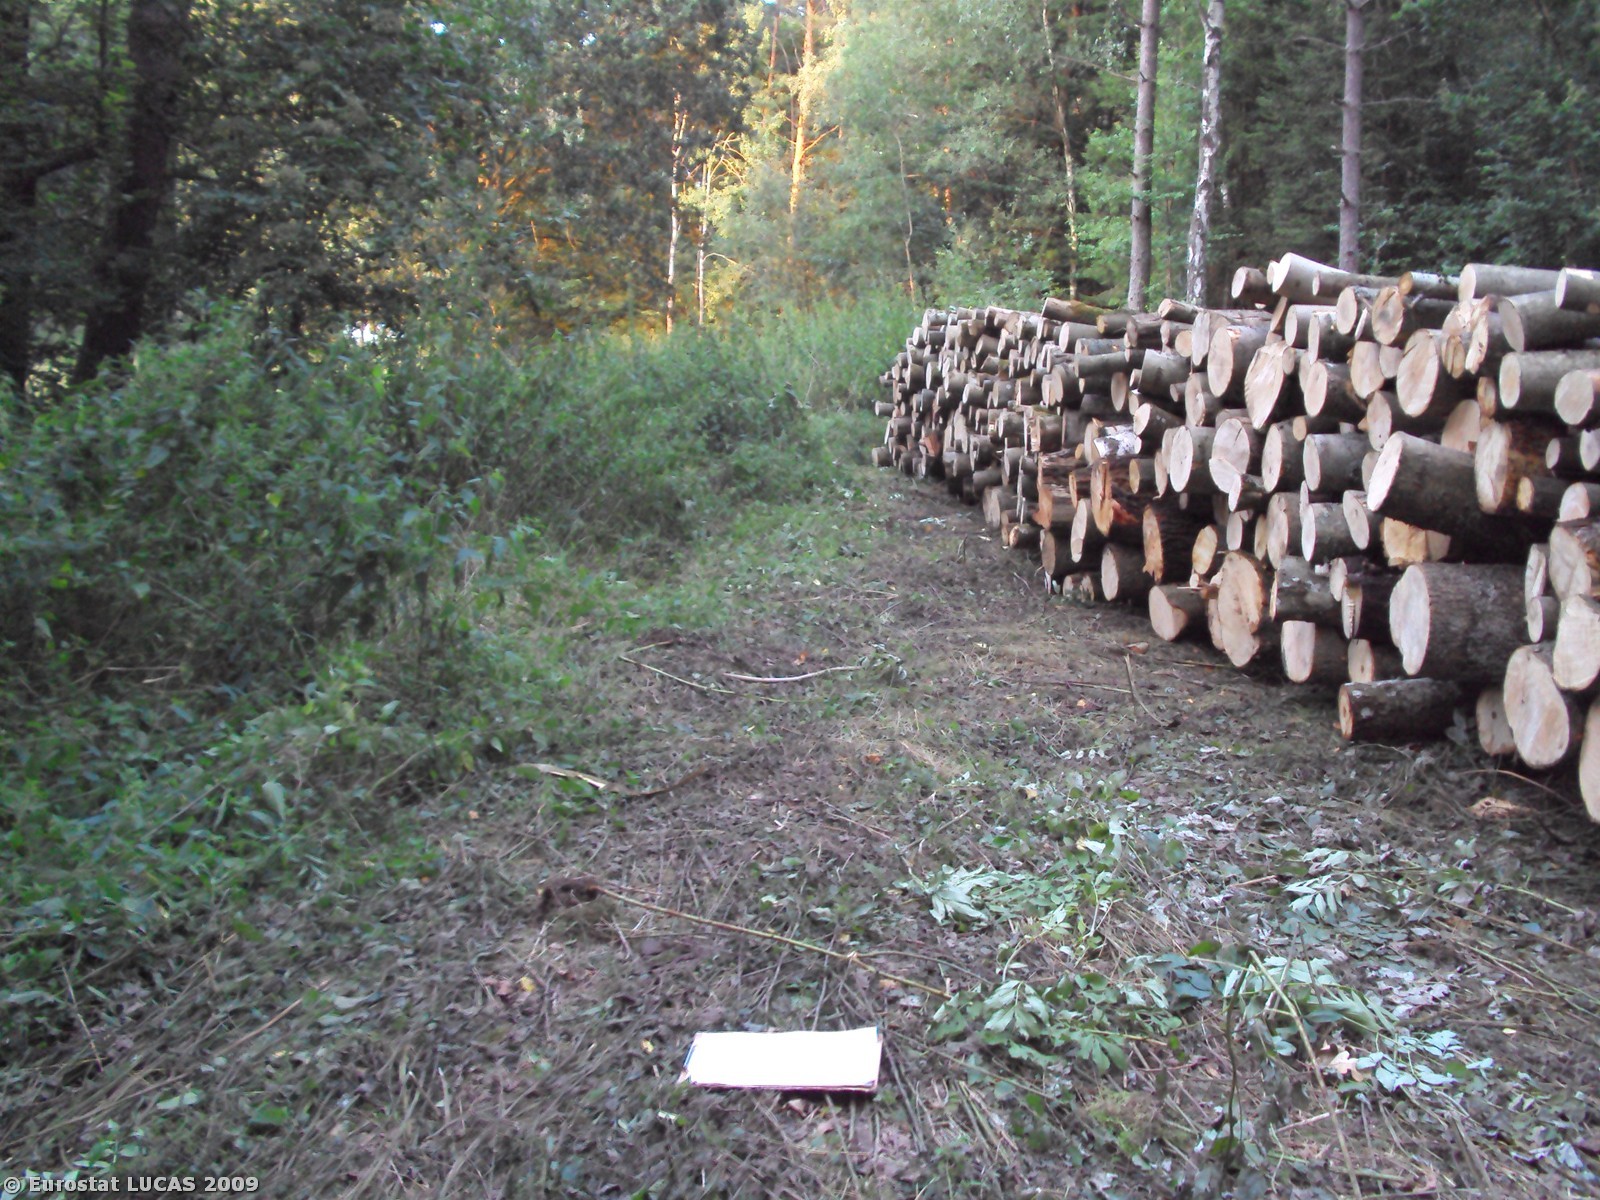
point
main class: Woodland
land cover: Mixed woodland
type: hemiboreal forest and nemoral coniferous forest and mixed broadleaved-coniferous forest
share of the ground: 50 - 75 %
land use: Forestry
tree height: > 5 m
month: August
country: PL
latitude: 53.3270
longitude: 15.9656
